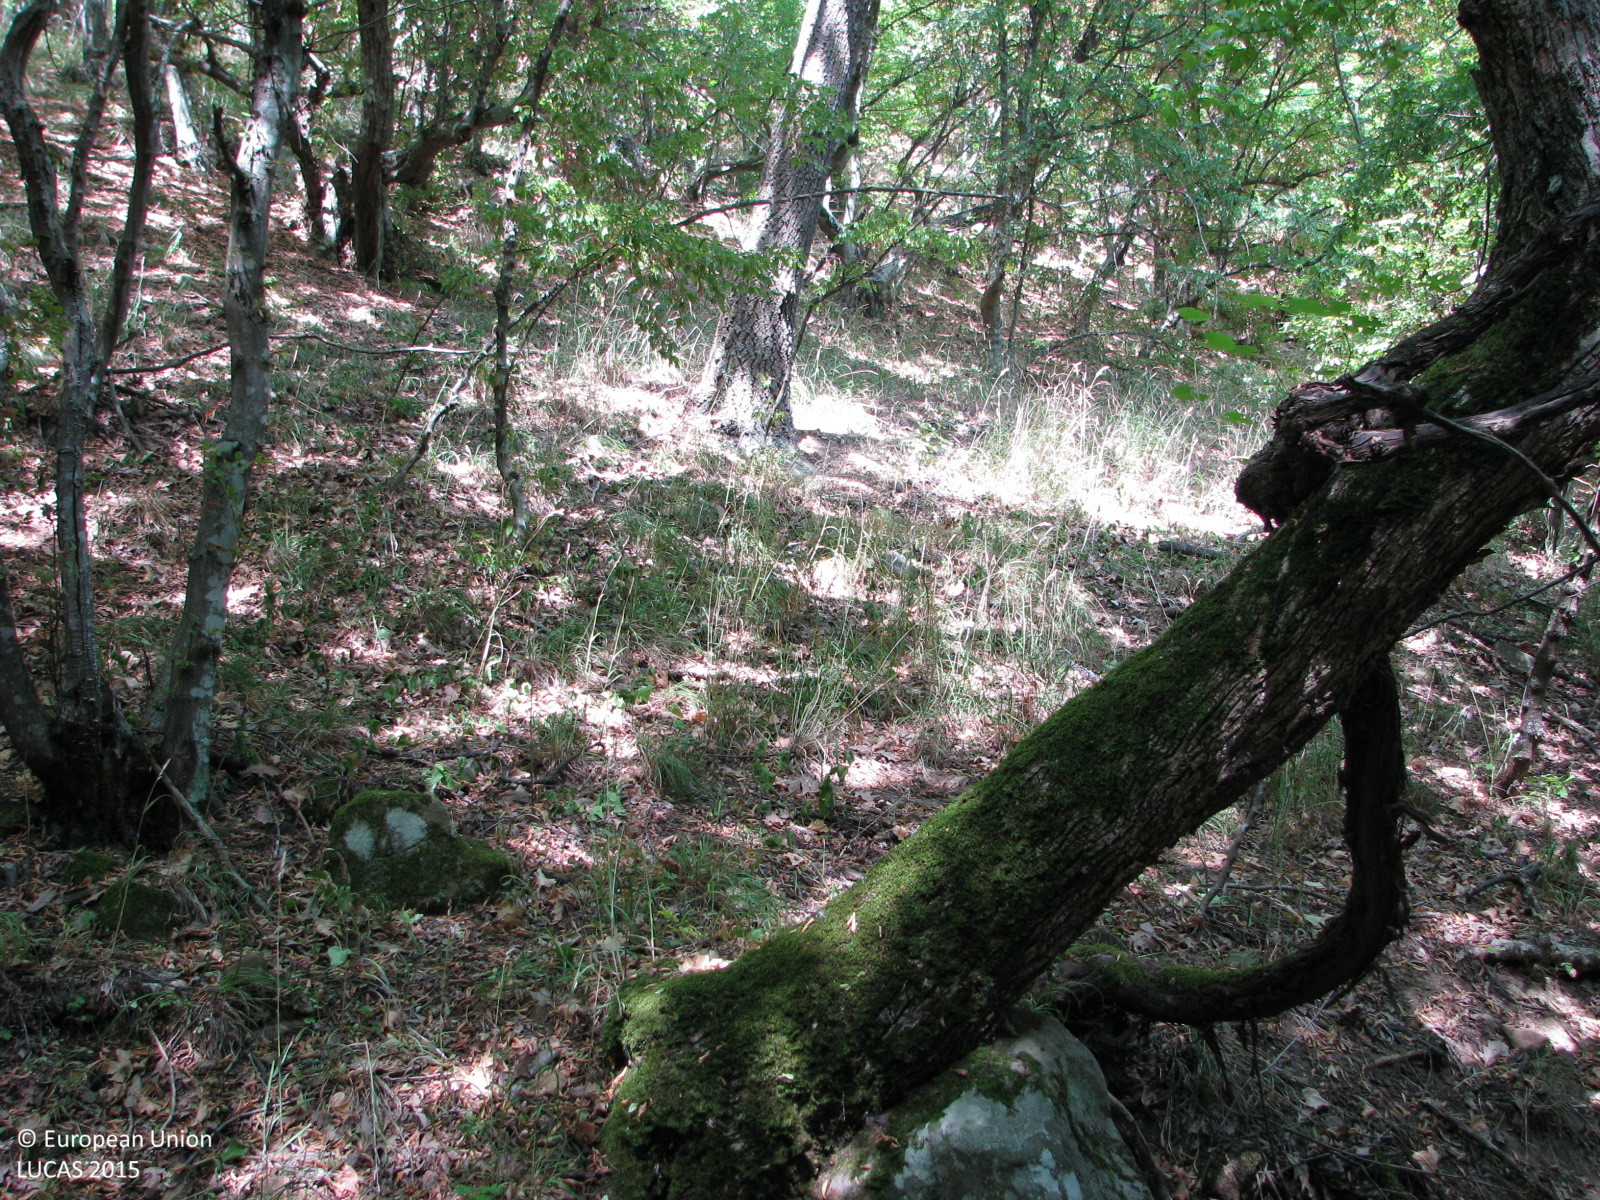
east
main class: Woodland
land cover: Broadleaved woodland
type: beech forest
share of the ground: 50 - 75 %
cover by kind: broadleaved forest trees 65 %, unconsolidated bare surface 25 %, herbaceous plants 10 %
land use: Forestry
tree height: > 5 m
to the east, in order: Broadleaved woodland; Tracks; Broadleaved woodland
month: August
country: BG
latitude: 42.7540
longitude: 26.6548
